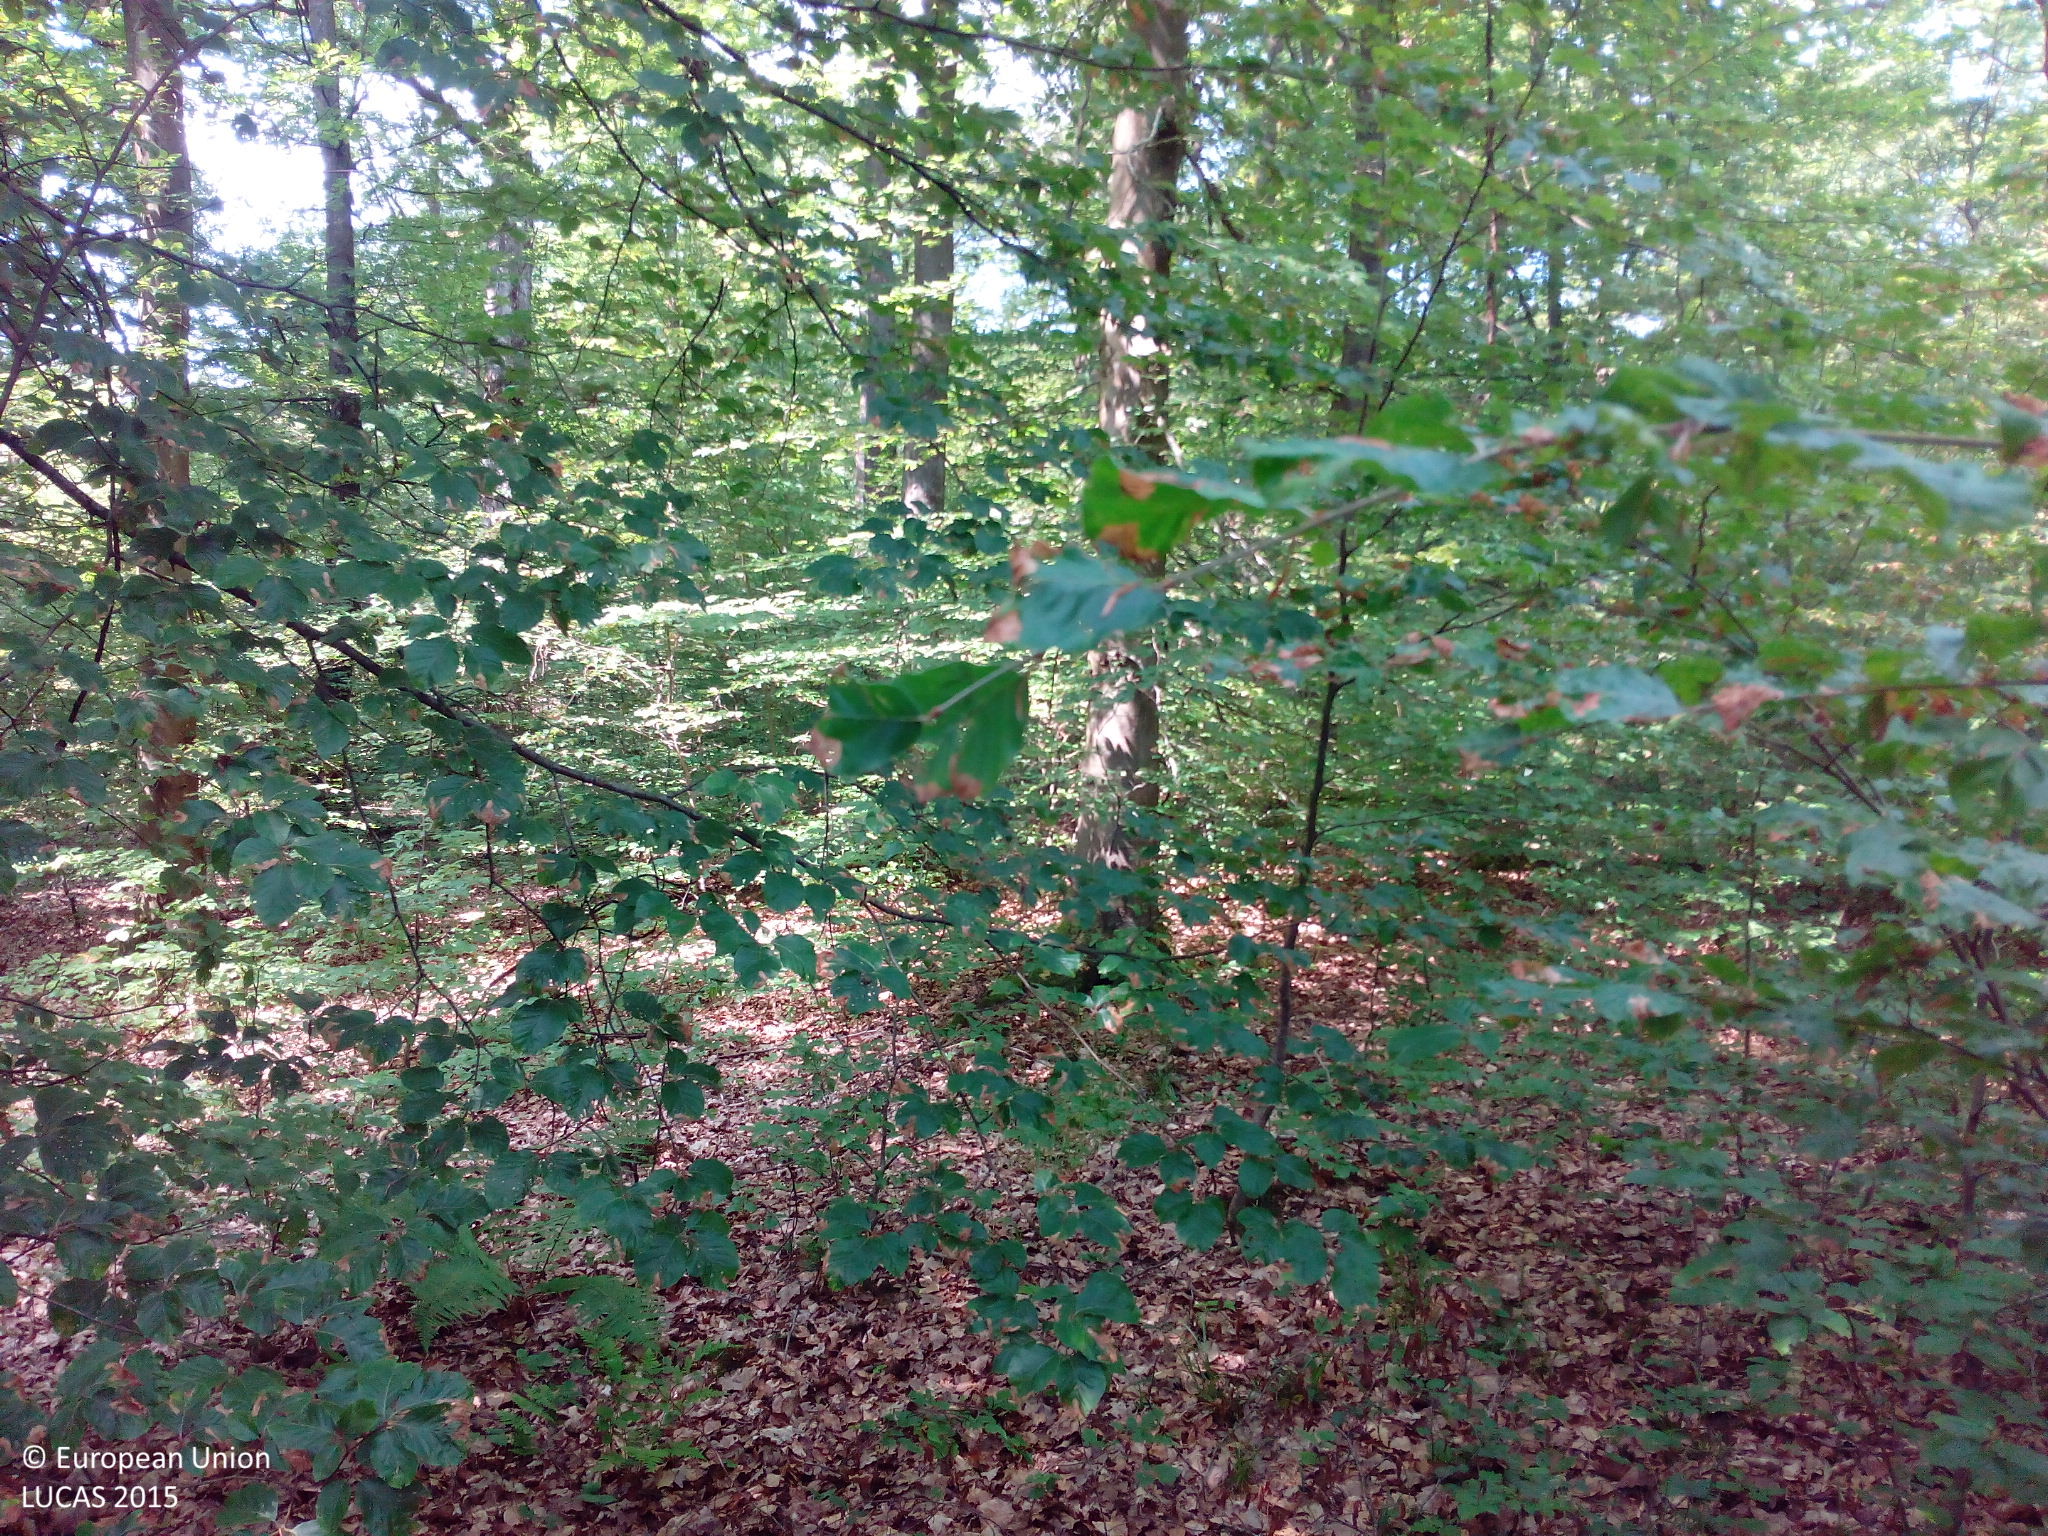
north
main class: Woodland
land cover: Broadleaved woodland
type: mesophytic deciduous forest
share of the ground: > 75 %
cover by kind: broadleaved forest trees 100 %
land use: Forestry
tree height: > 5 m
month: June
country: DE
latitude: 49.4080
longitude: 9.1872
